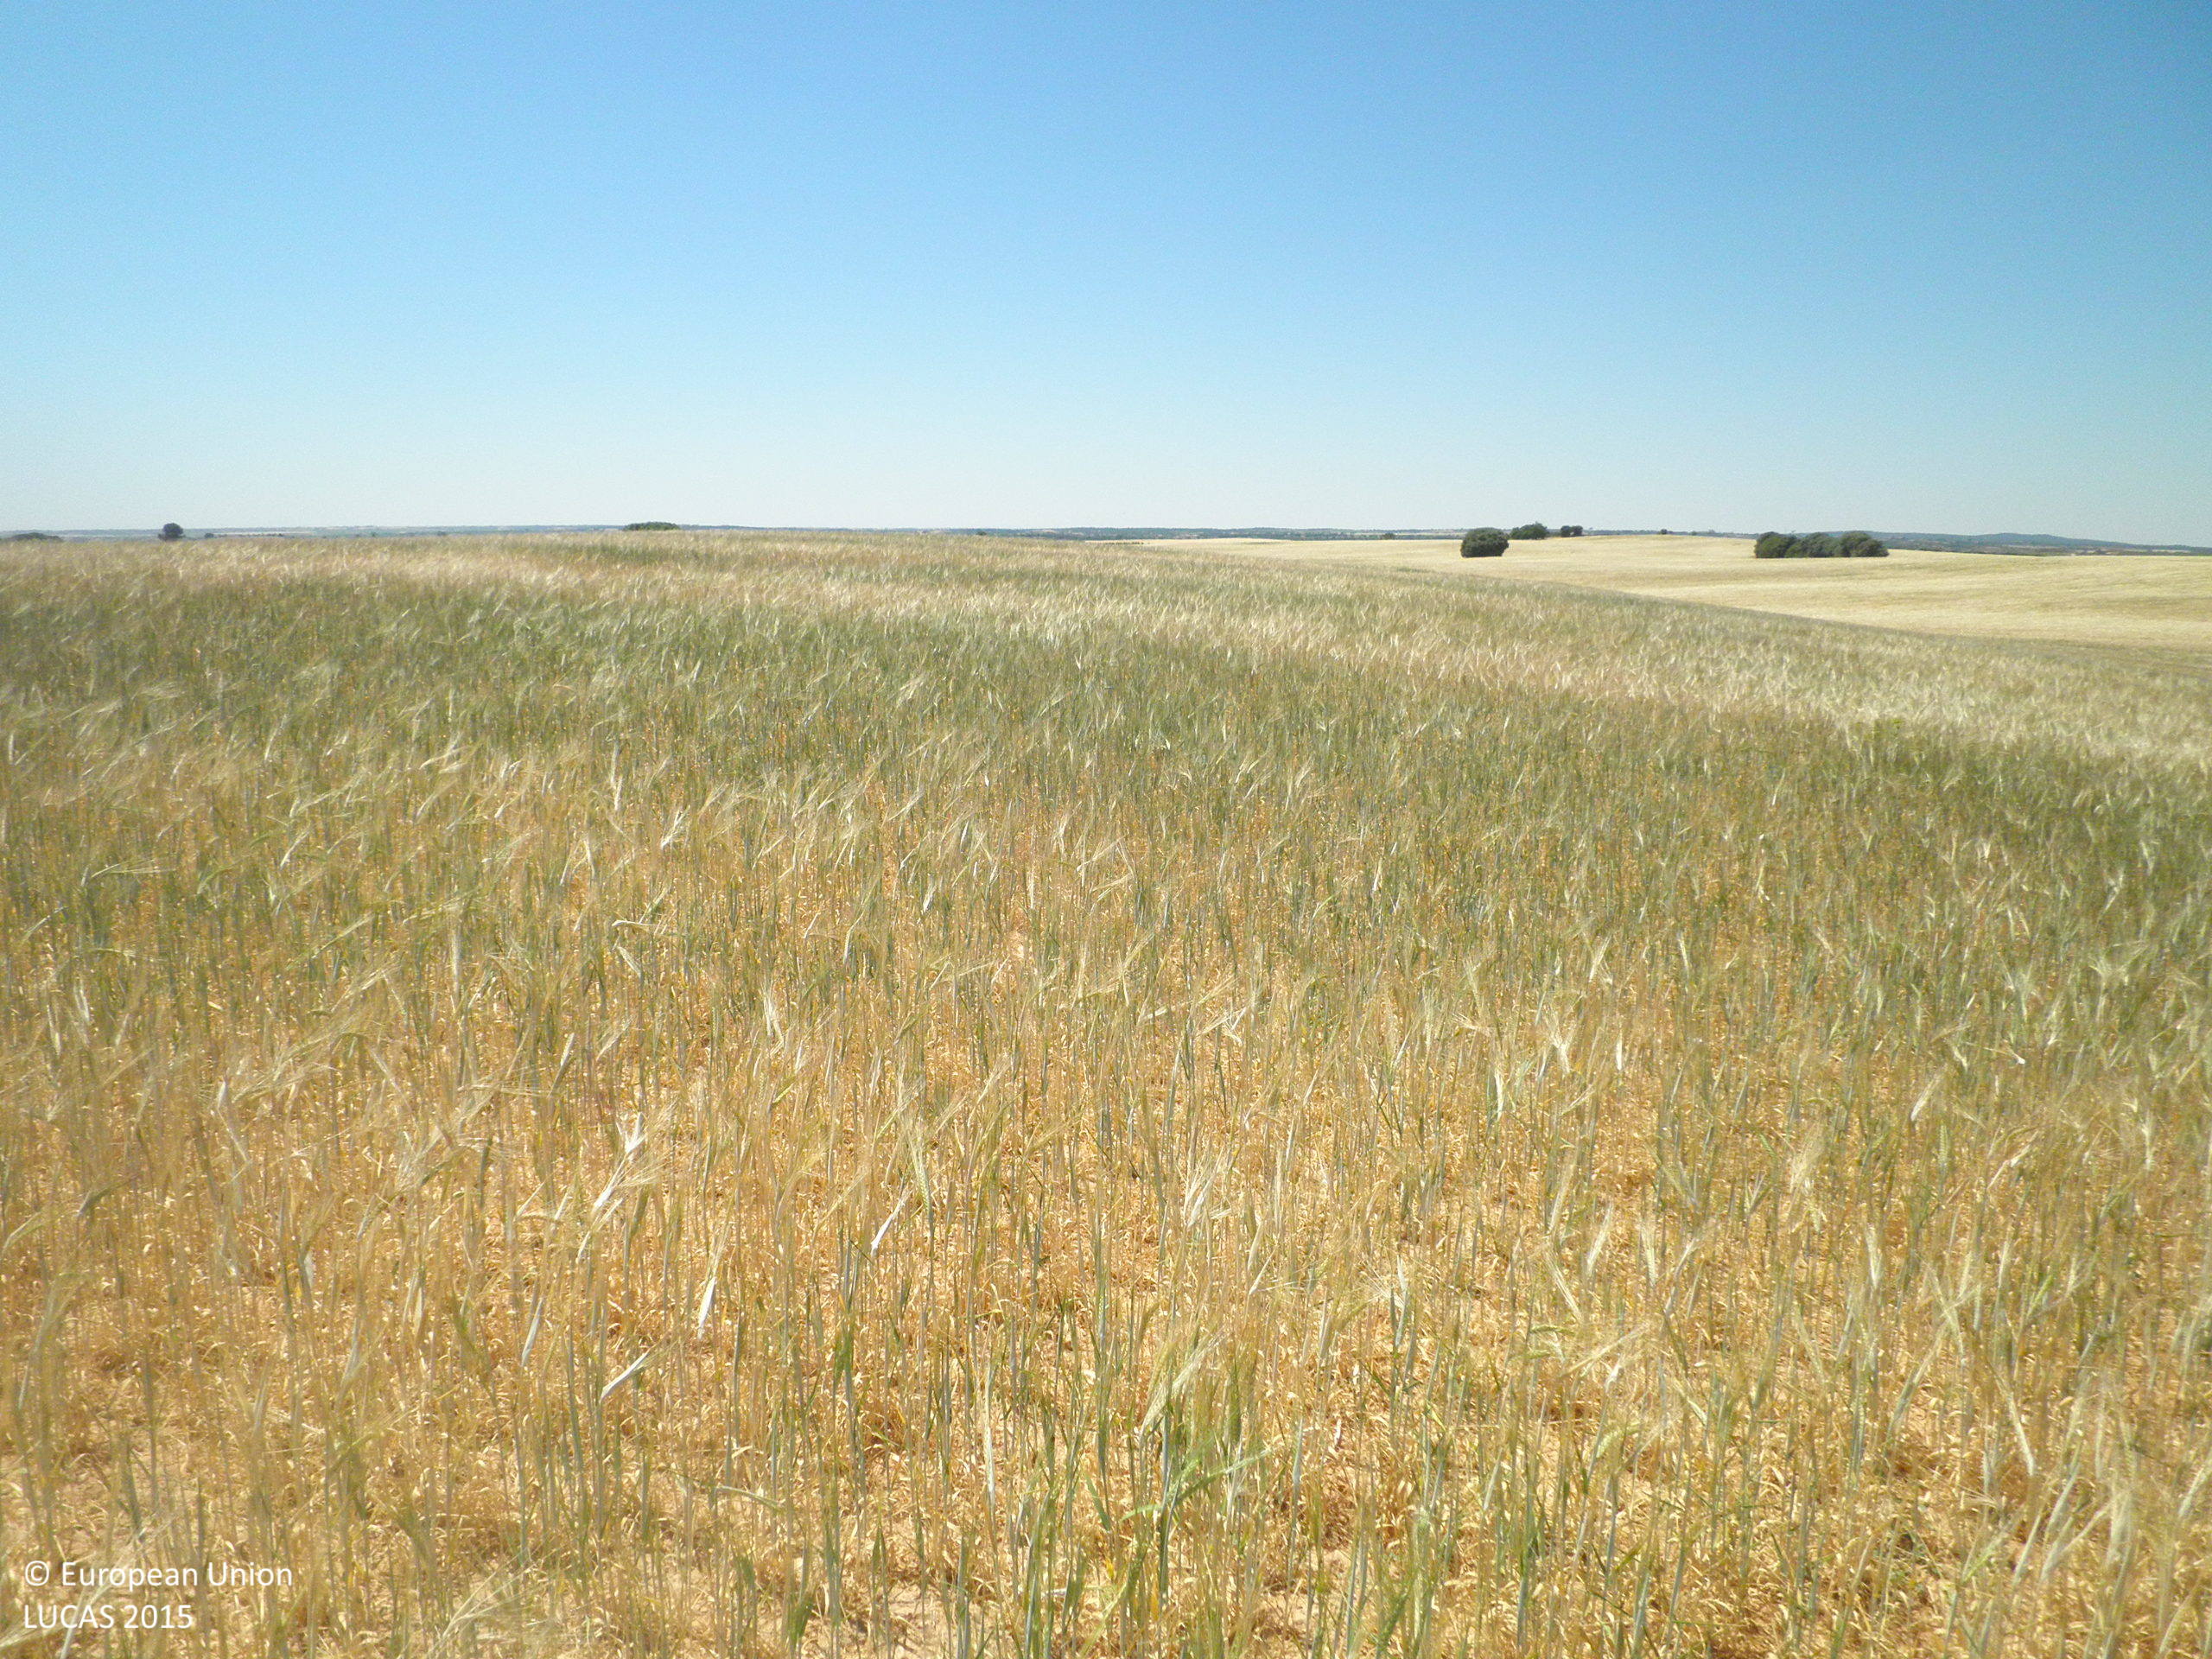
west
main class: Cropland
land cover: Barley
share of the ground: 50 - 75 %
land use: Agriculture (excluding fallow land and kitchen gardens)
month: June
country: ES
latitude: 39.4955
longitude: -1.6682
